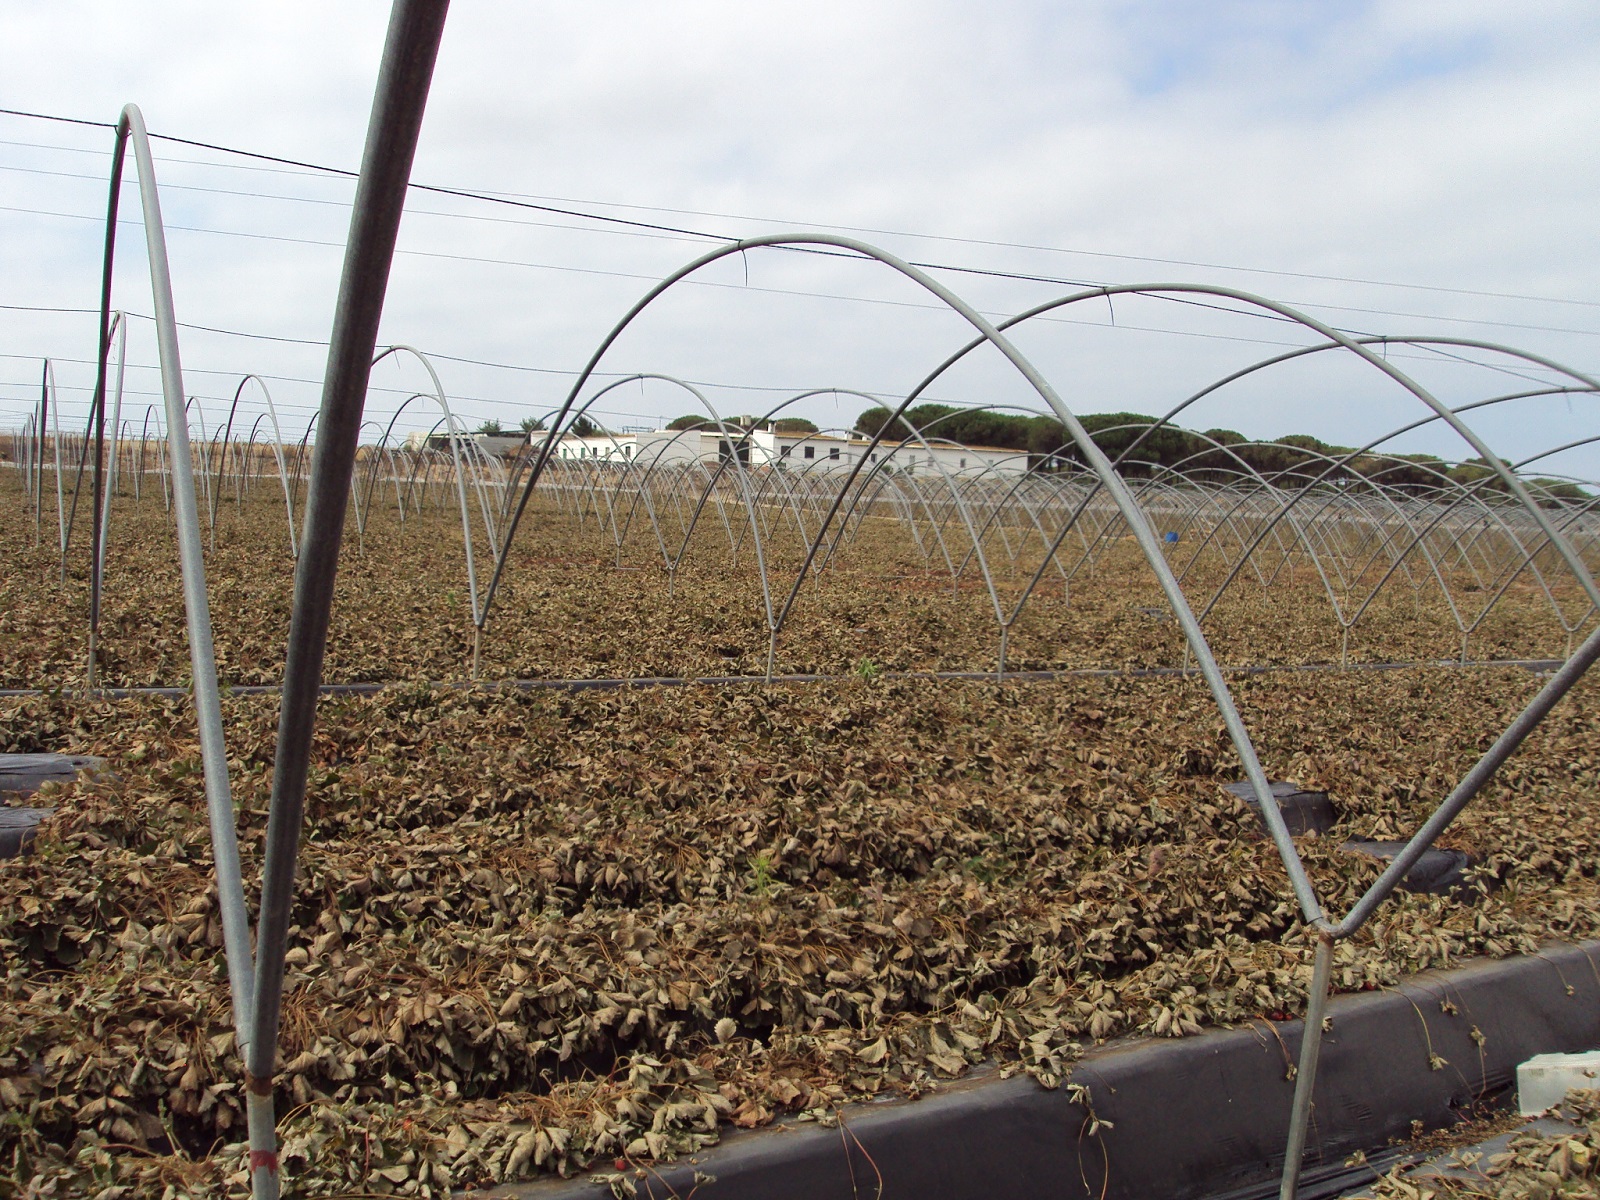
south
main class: Artificial land
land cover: Greenhouses
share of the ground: > 75 %
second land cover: Strawberries
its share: > 75 %
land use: Agriculture (excluding fallow land and kitchen gardens)
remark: Harvested field
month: June
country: ES
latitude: 37.1743
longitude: -6.8499
